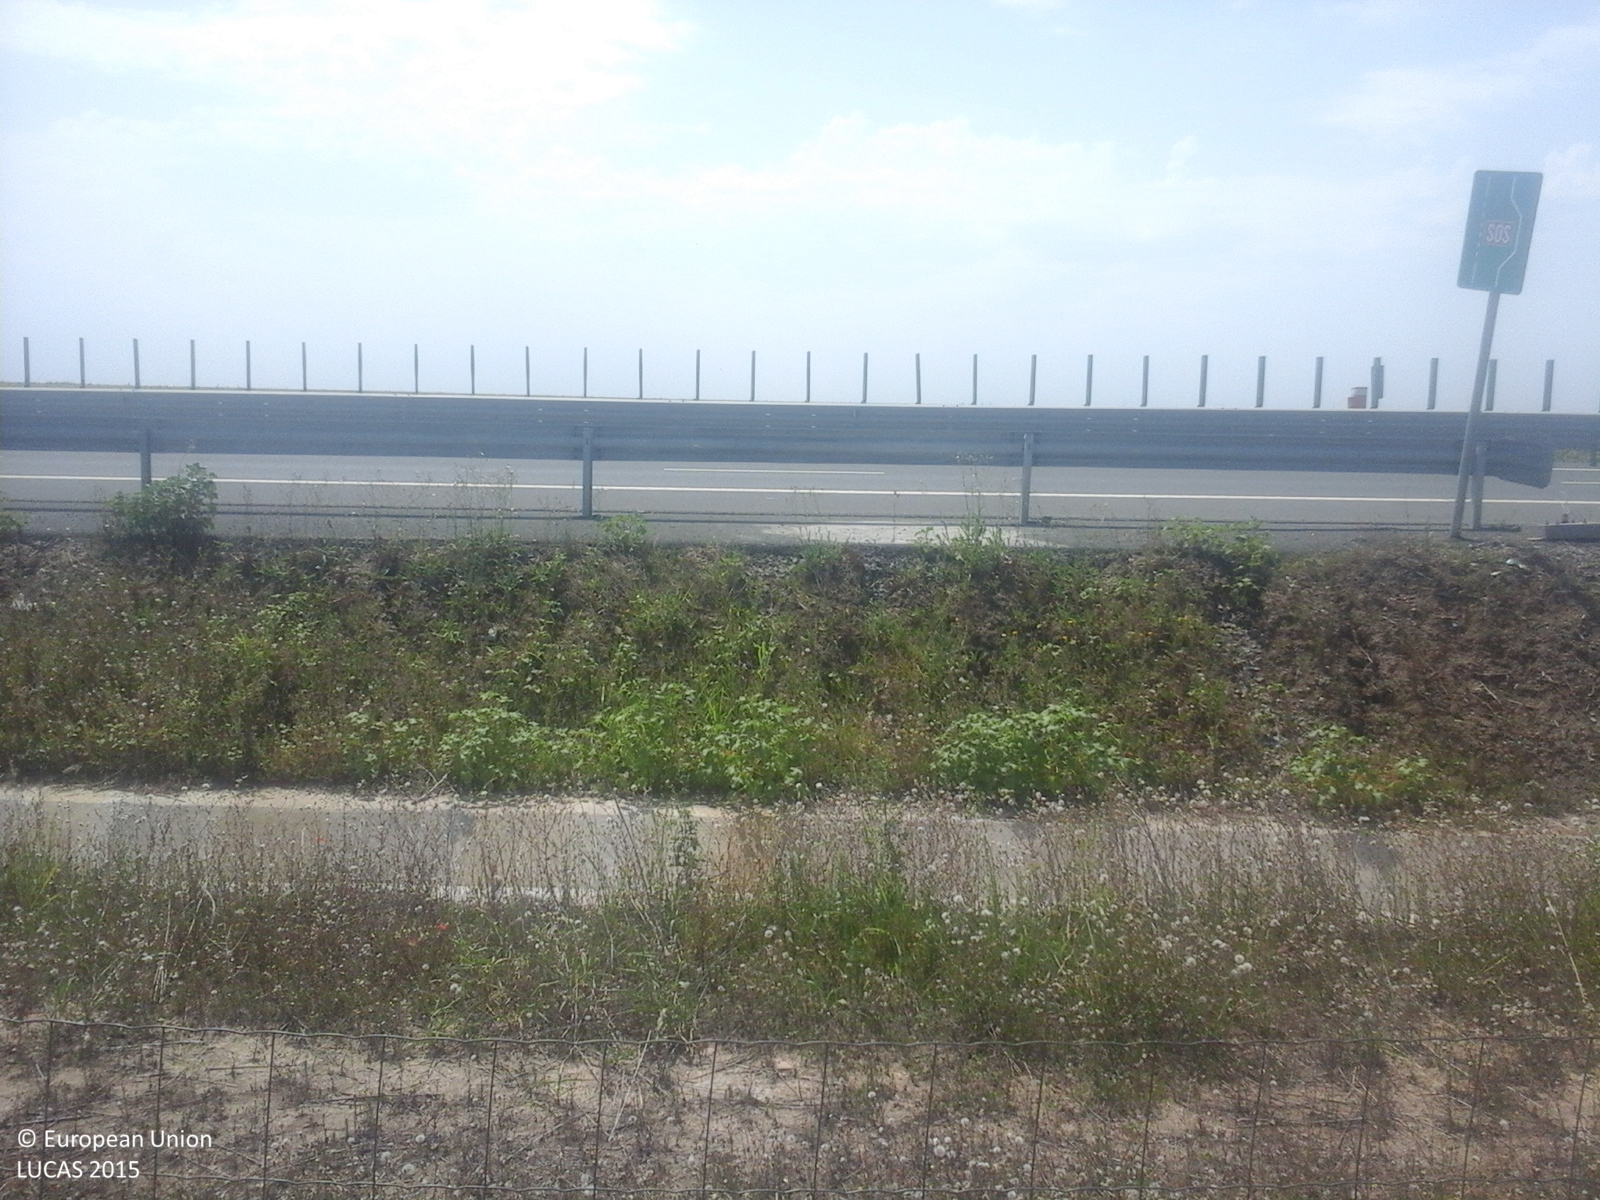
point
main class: Cropland
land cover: Sunflower
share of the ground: > 75 %
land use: Agriculture (excluding fallow land and kitchen gardens)
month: August
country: RO
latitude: 44.1801
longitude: 28.3141
